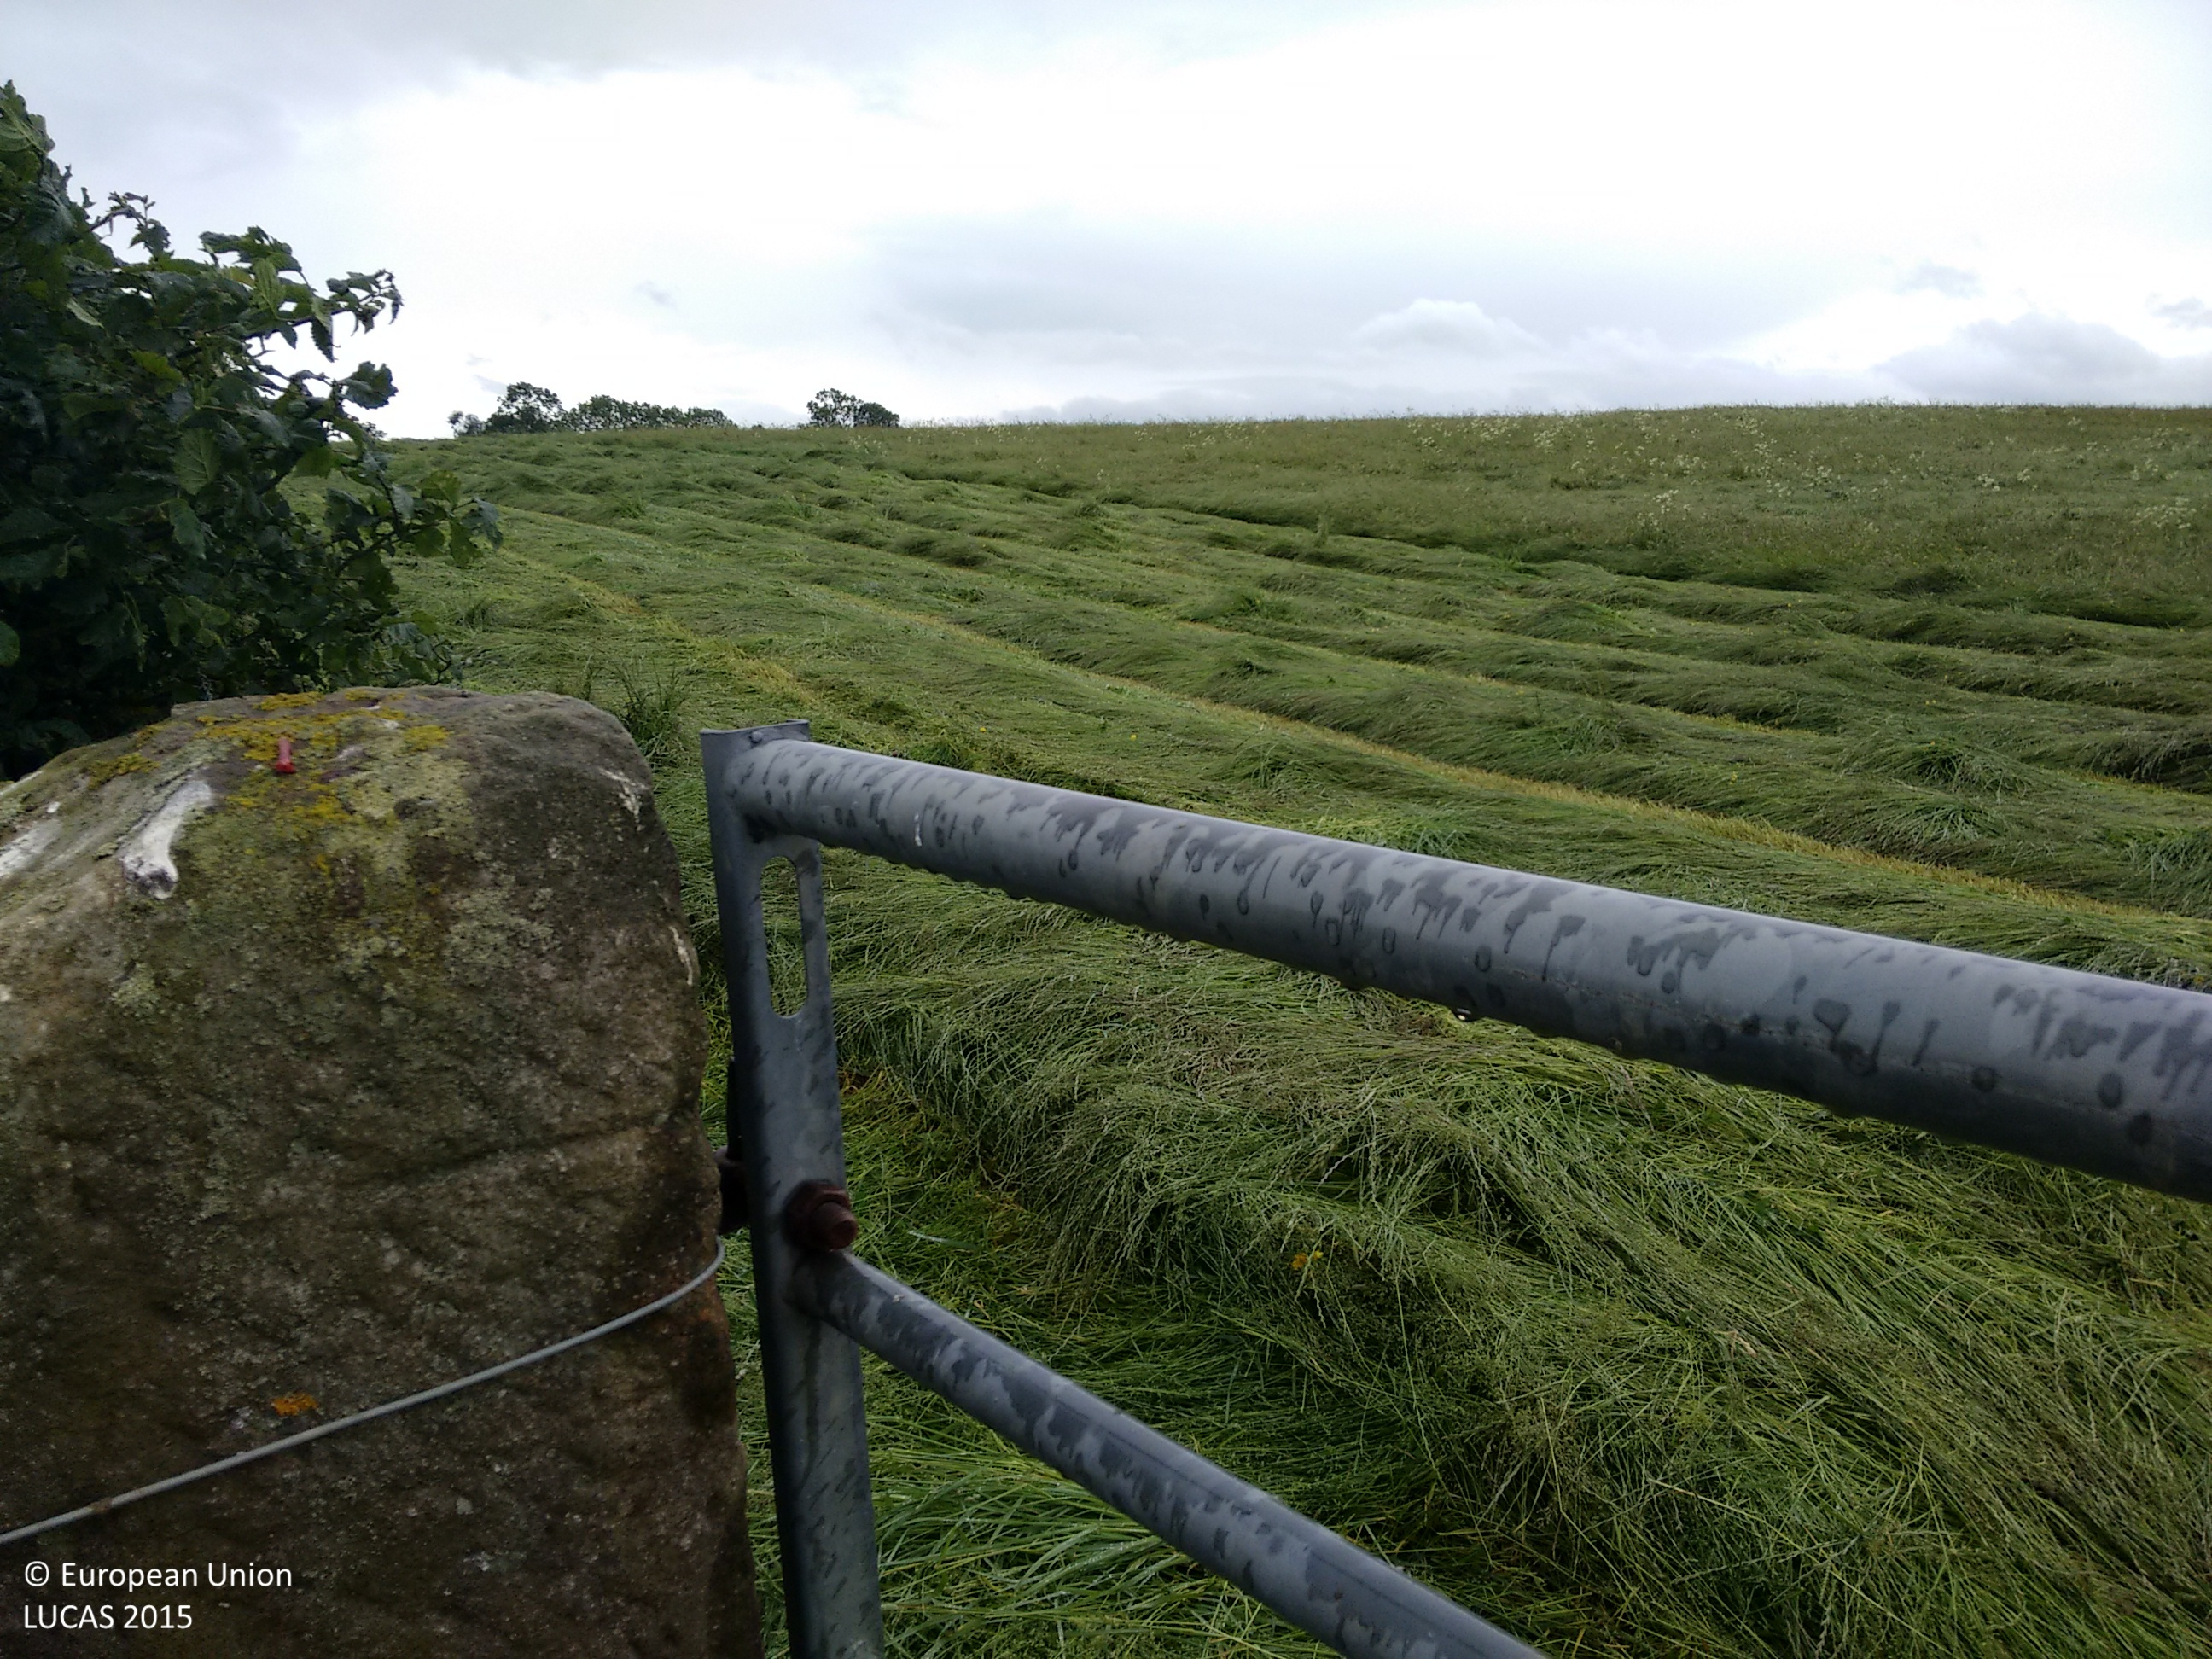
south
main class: Grassland
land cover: Grassland without tree/shrub cover
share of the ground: > 75 %
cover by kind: herbaceous plants 100 %
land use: Agriculture (excluding fallow land and kitchen gardens)
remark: Harvested field
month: June
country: GB
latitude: 54.2560
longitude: -1.6402
